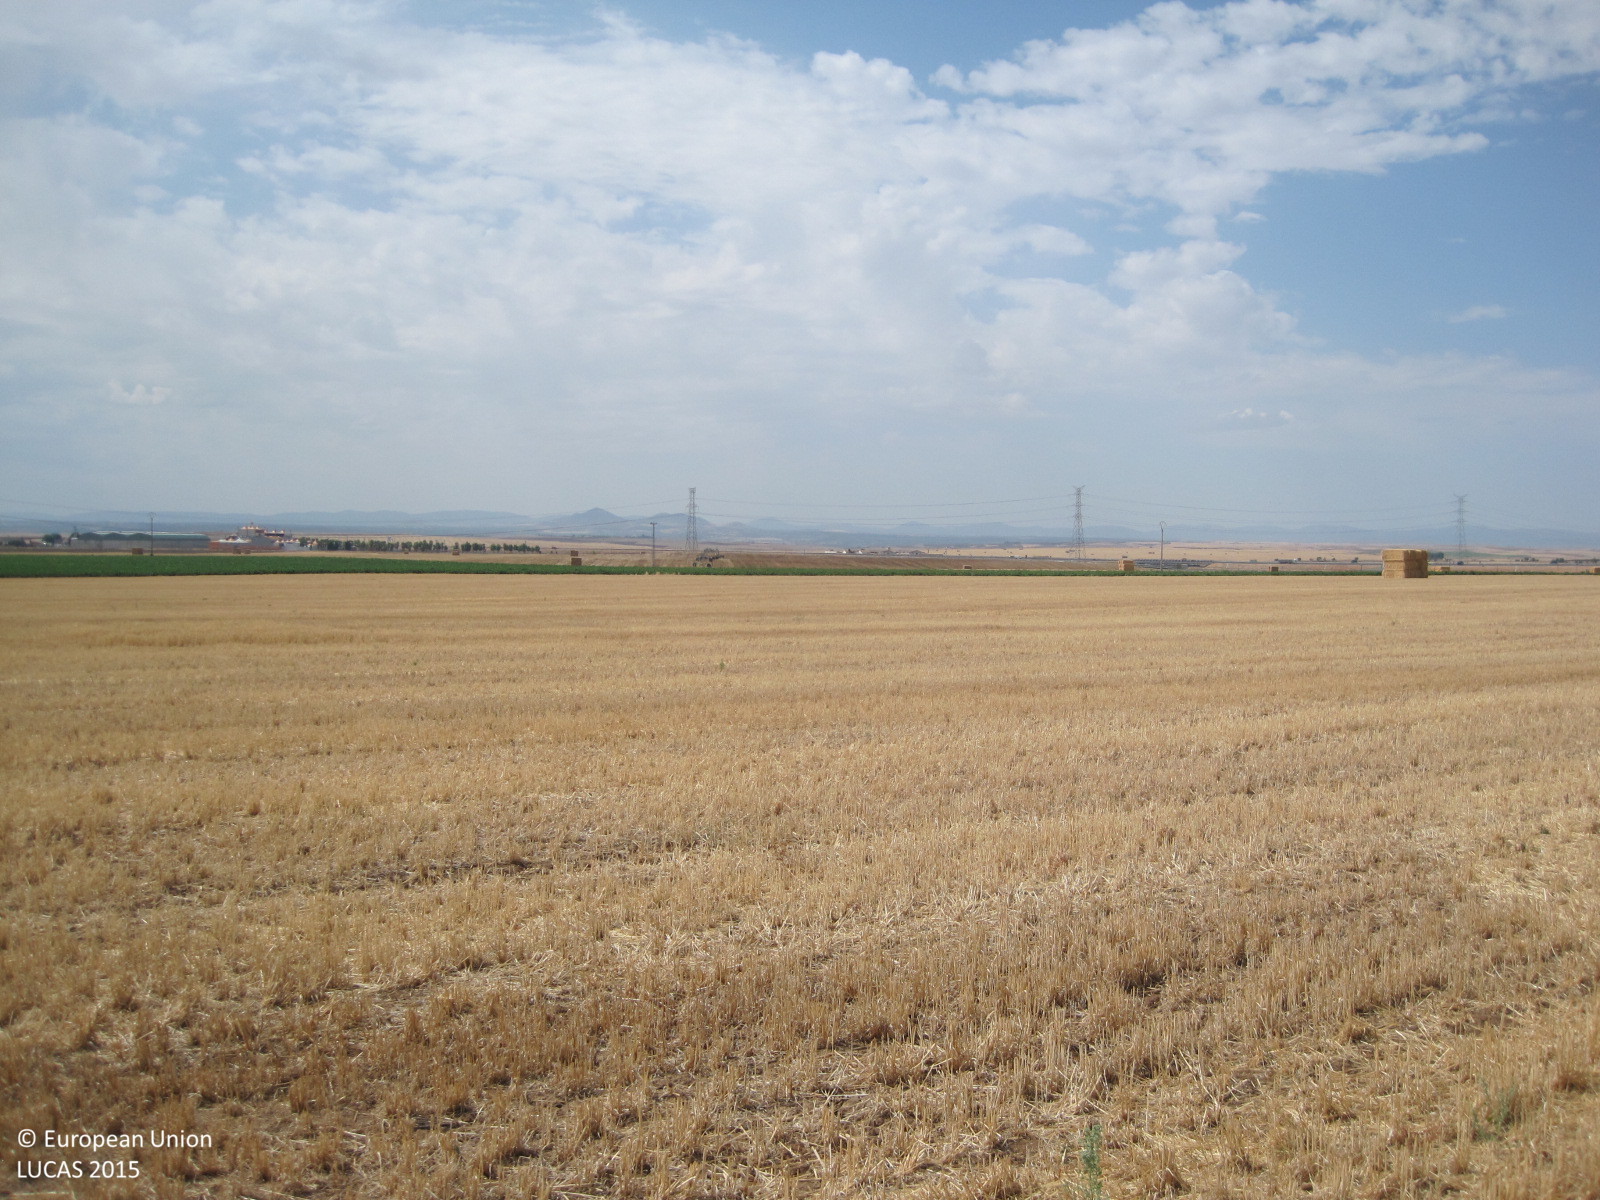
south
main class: Cropland
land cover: Barley
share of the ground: < 10 %
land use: Agriculture (excluding fallow land and kitchen gardens)
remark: Harvested field
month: July
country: ES
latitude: 39.9777
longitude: -4.2189
